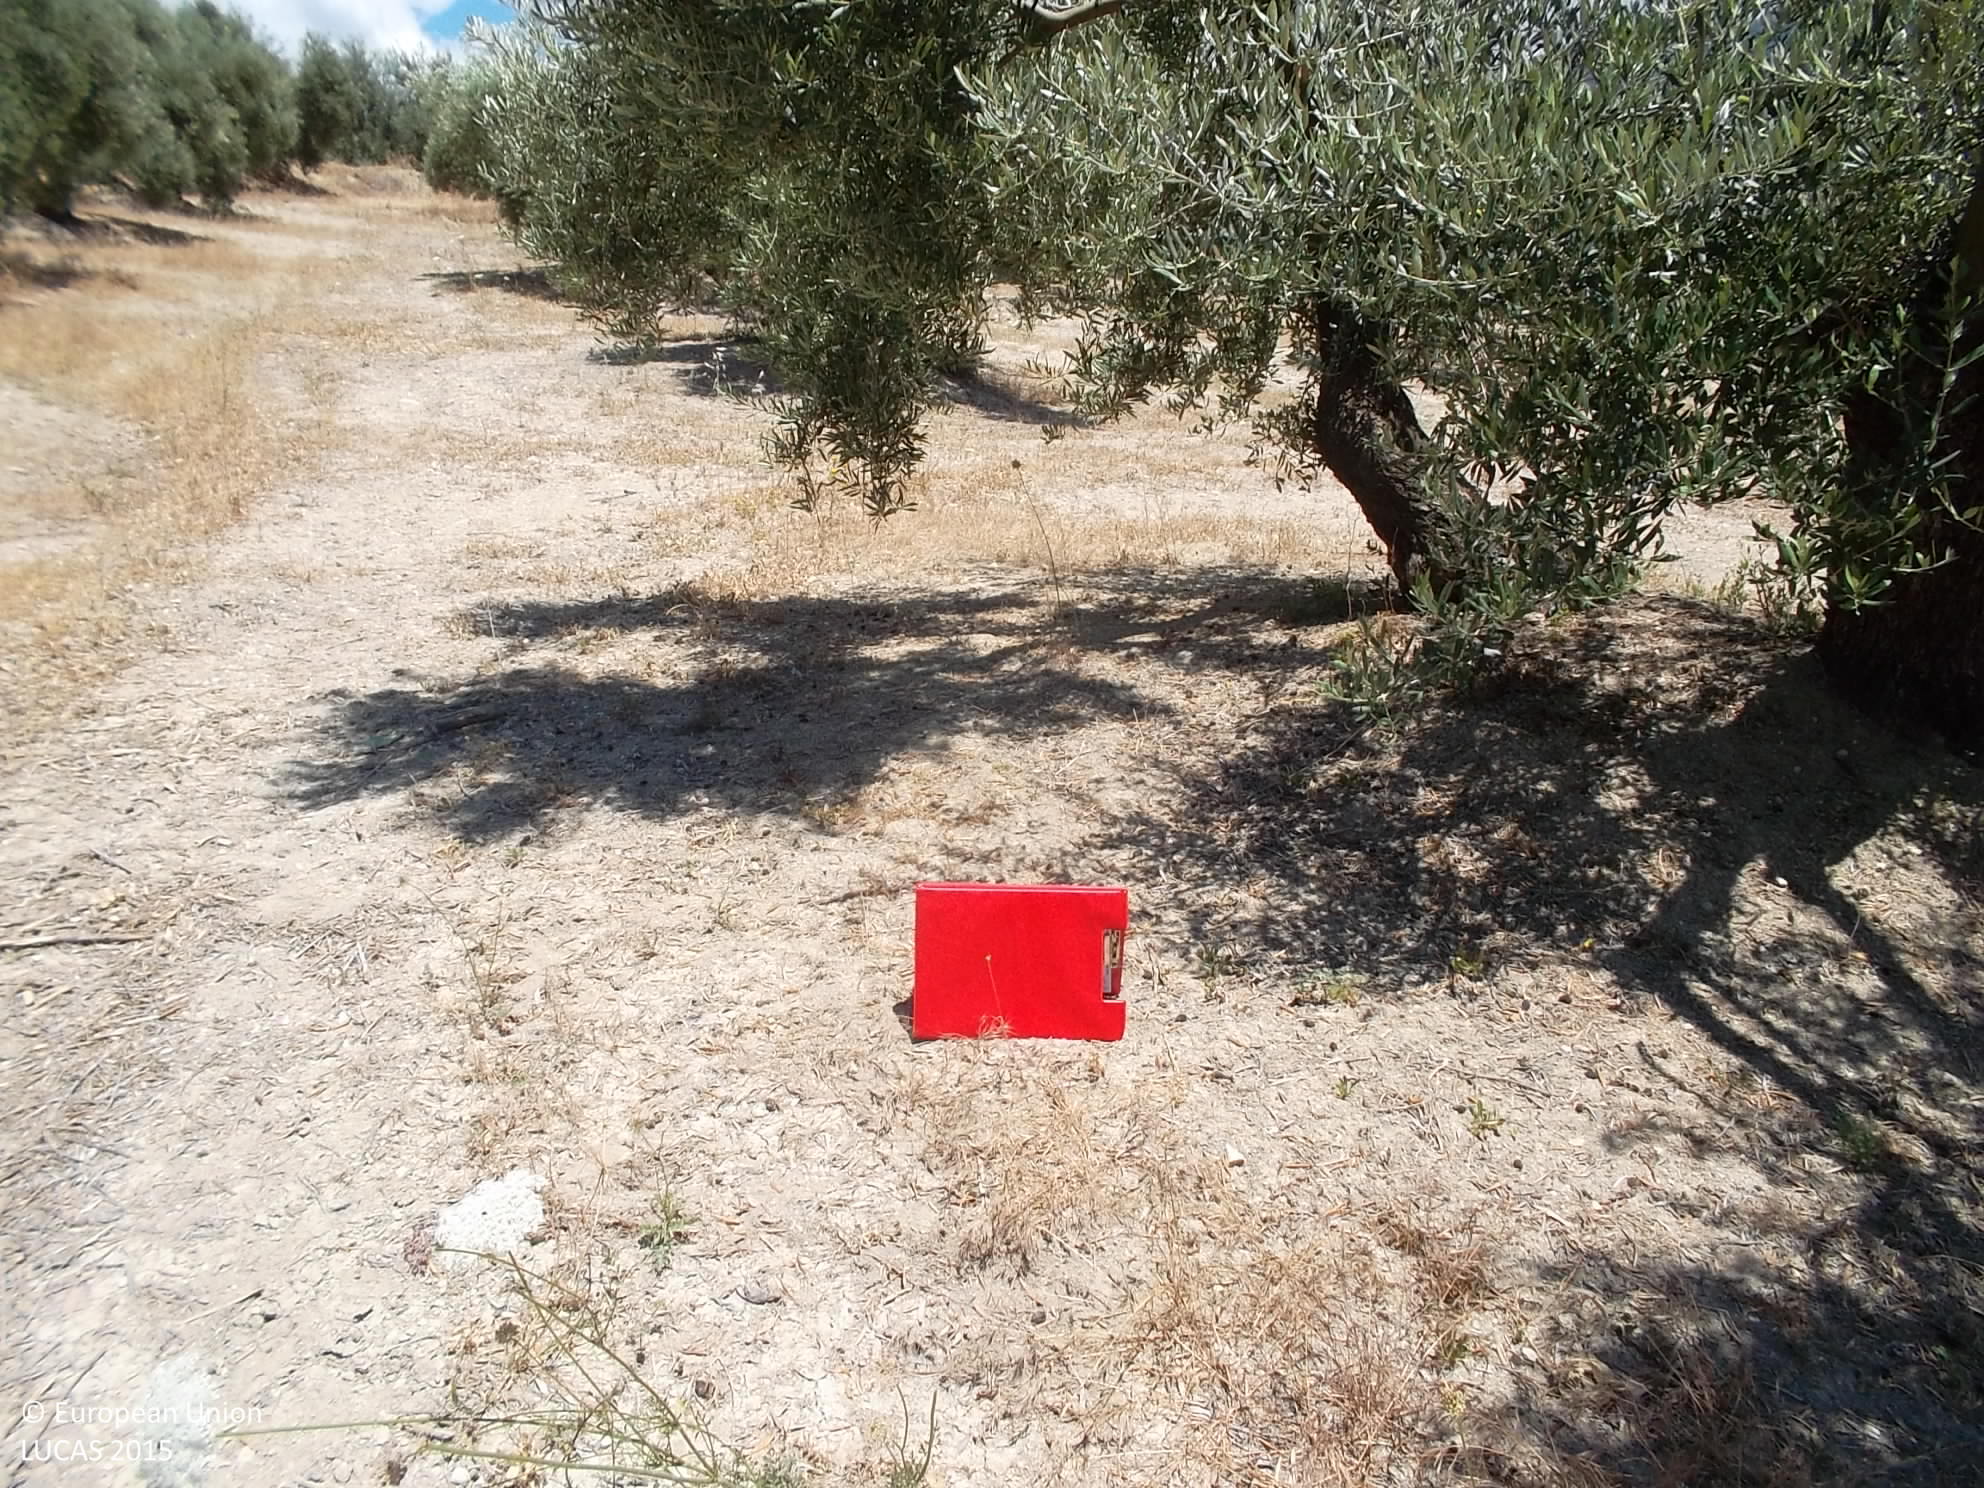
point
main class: Cropland
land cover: Olive groves
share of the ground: 25 - 50 %
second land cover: Other bare soil
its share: > 75 %
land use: Agriculture (excluding fallow land and kitchen gardens)
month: June
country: ES
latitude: 37.9509
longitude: -3.0035
